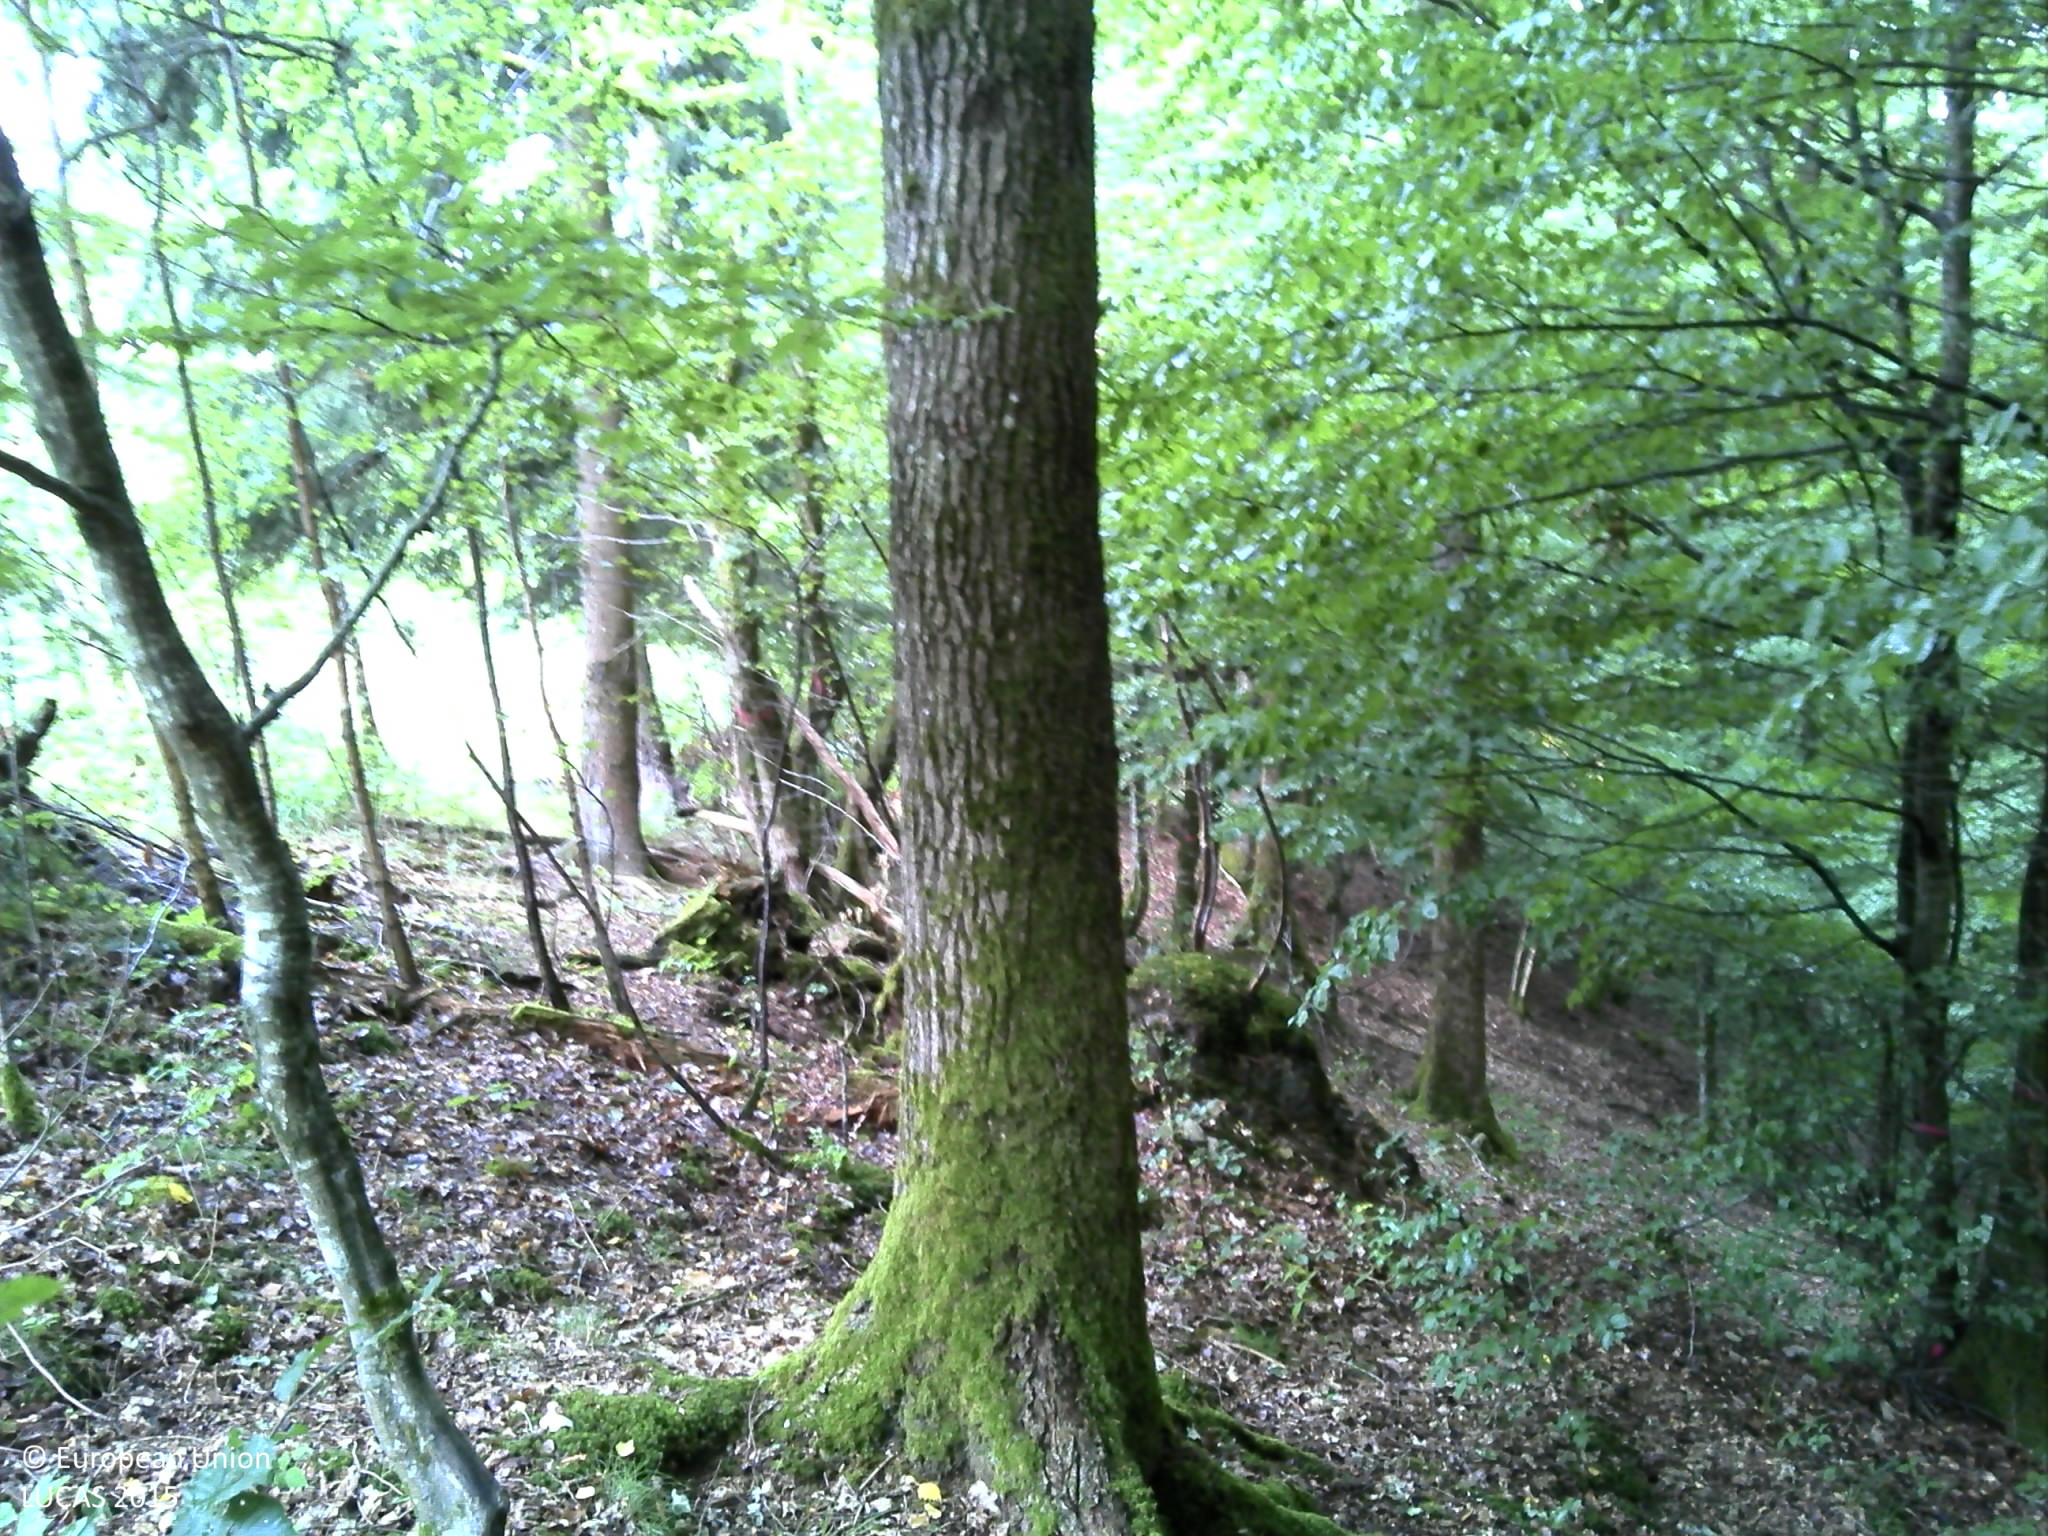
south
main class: Woodland
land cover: Spruce dominated mixed woodland
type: beech forest
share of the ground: > 75 %
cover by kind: broadleaved forest trees 55 %, coniferous forest trees 25 %, herbaceous plants 10 %, lichens and mosses 5 %, unconsolidated bare surface 5 %
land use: Forestry
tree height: > 5 m
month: July
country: FR
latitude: 49.0823
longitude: 4.9730
